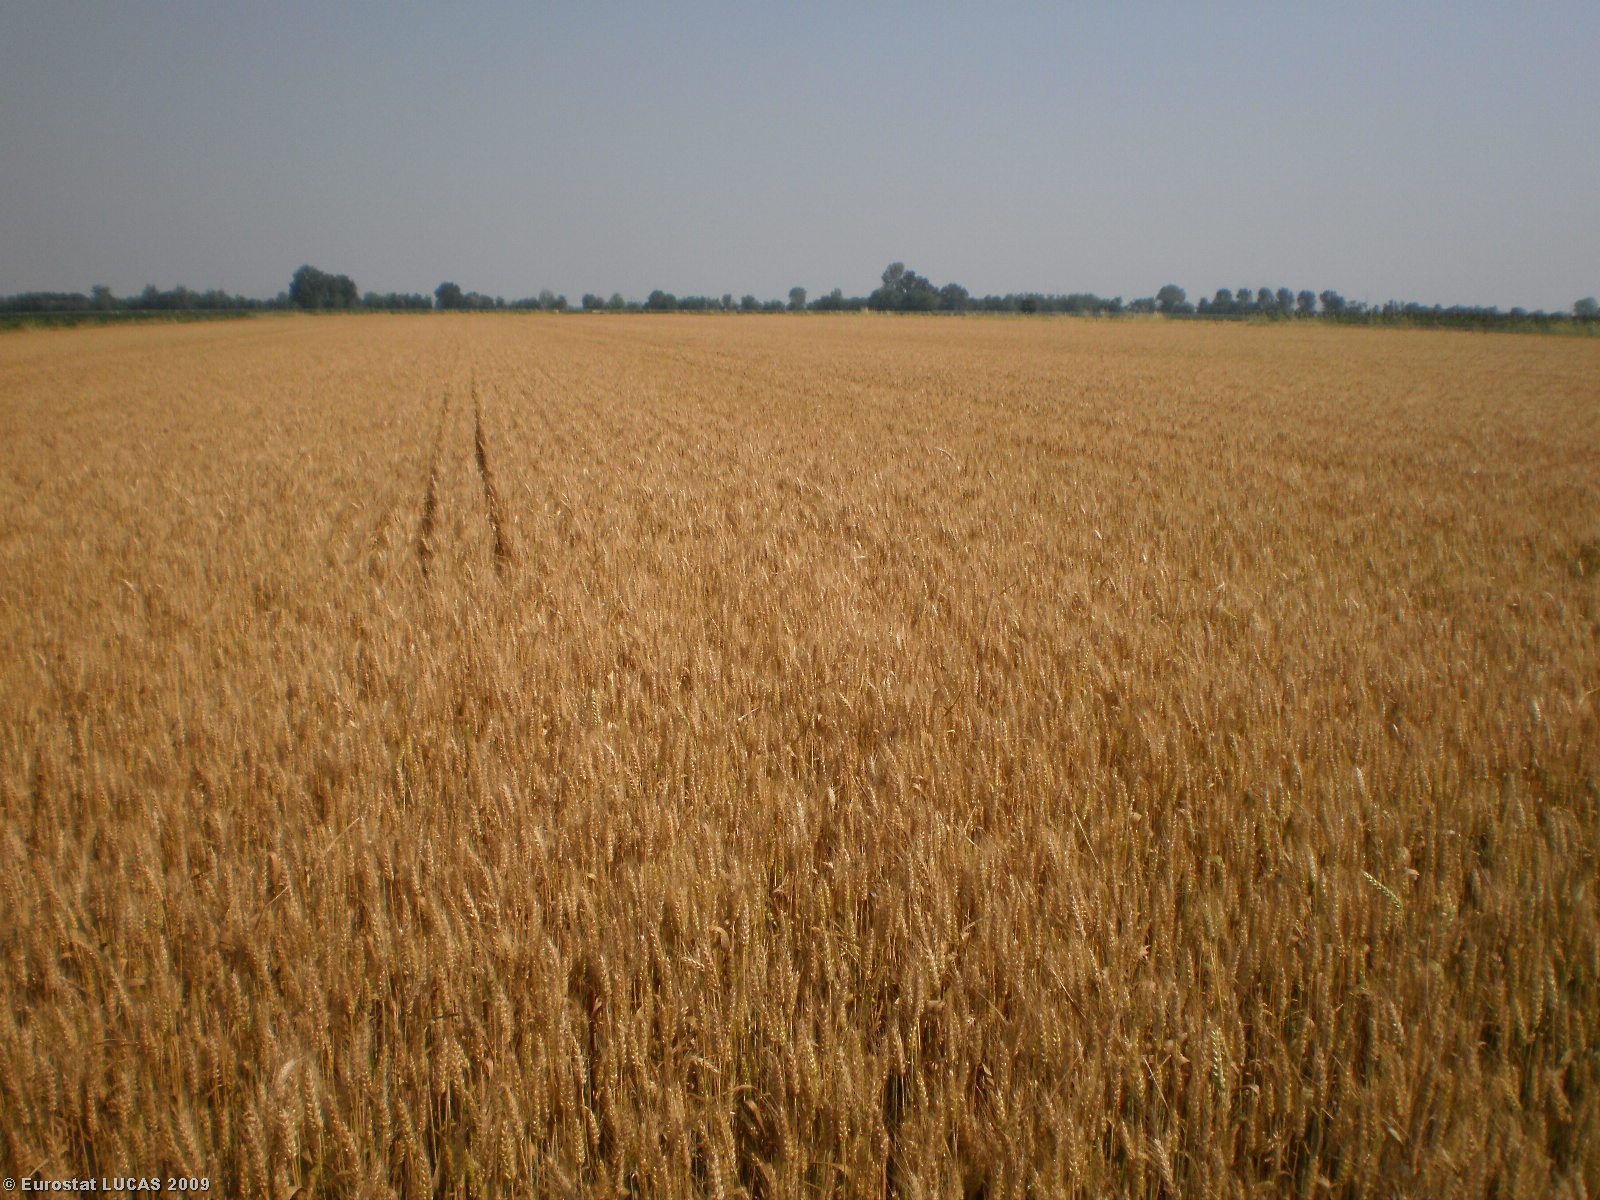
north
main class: Cropland
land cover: Common wheat
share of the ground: > 75 %
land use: Agriculture (excluding fallow land and kitchen gardens)
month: June
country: IT
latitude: 45.1073
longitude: 10.3425
